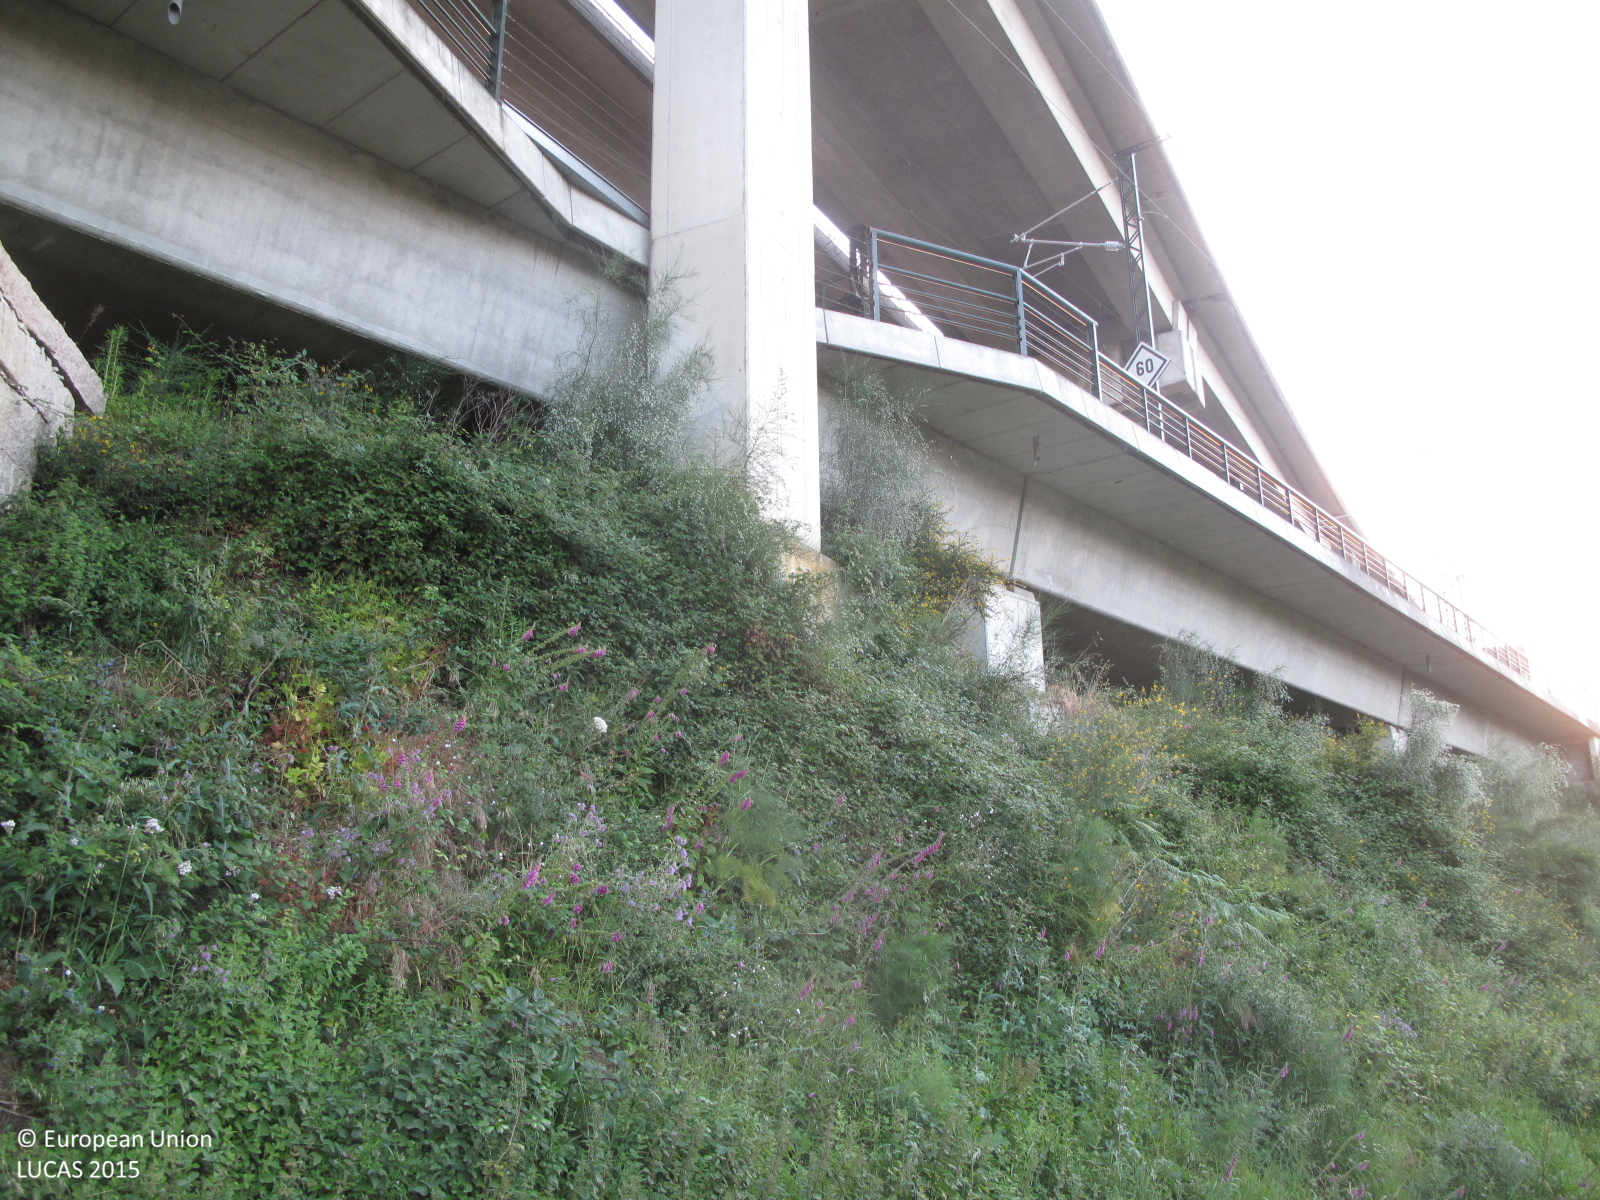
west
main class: Cropland
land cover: Other citrus fruit
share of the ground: 25 - 50 %
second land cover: Spontaneously vegetated surfaces
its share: 25 - 50 %
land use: Kitchen garden
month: June
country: ES
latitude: 42.8630
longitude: -8.5498
